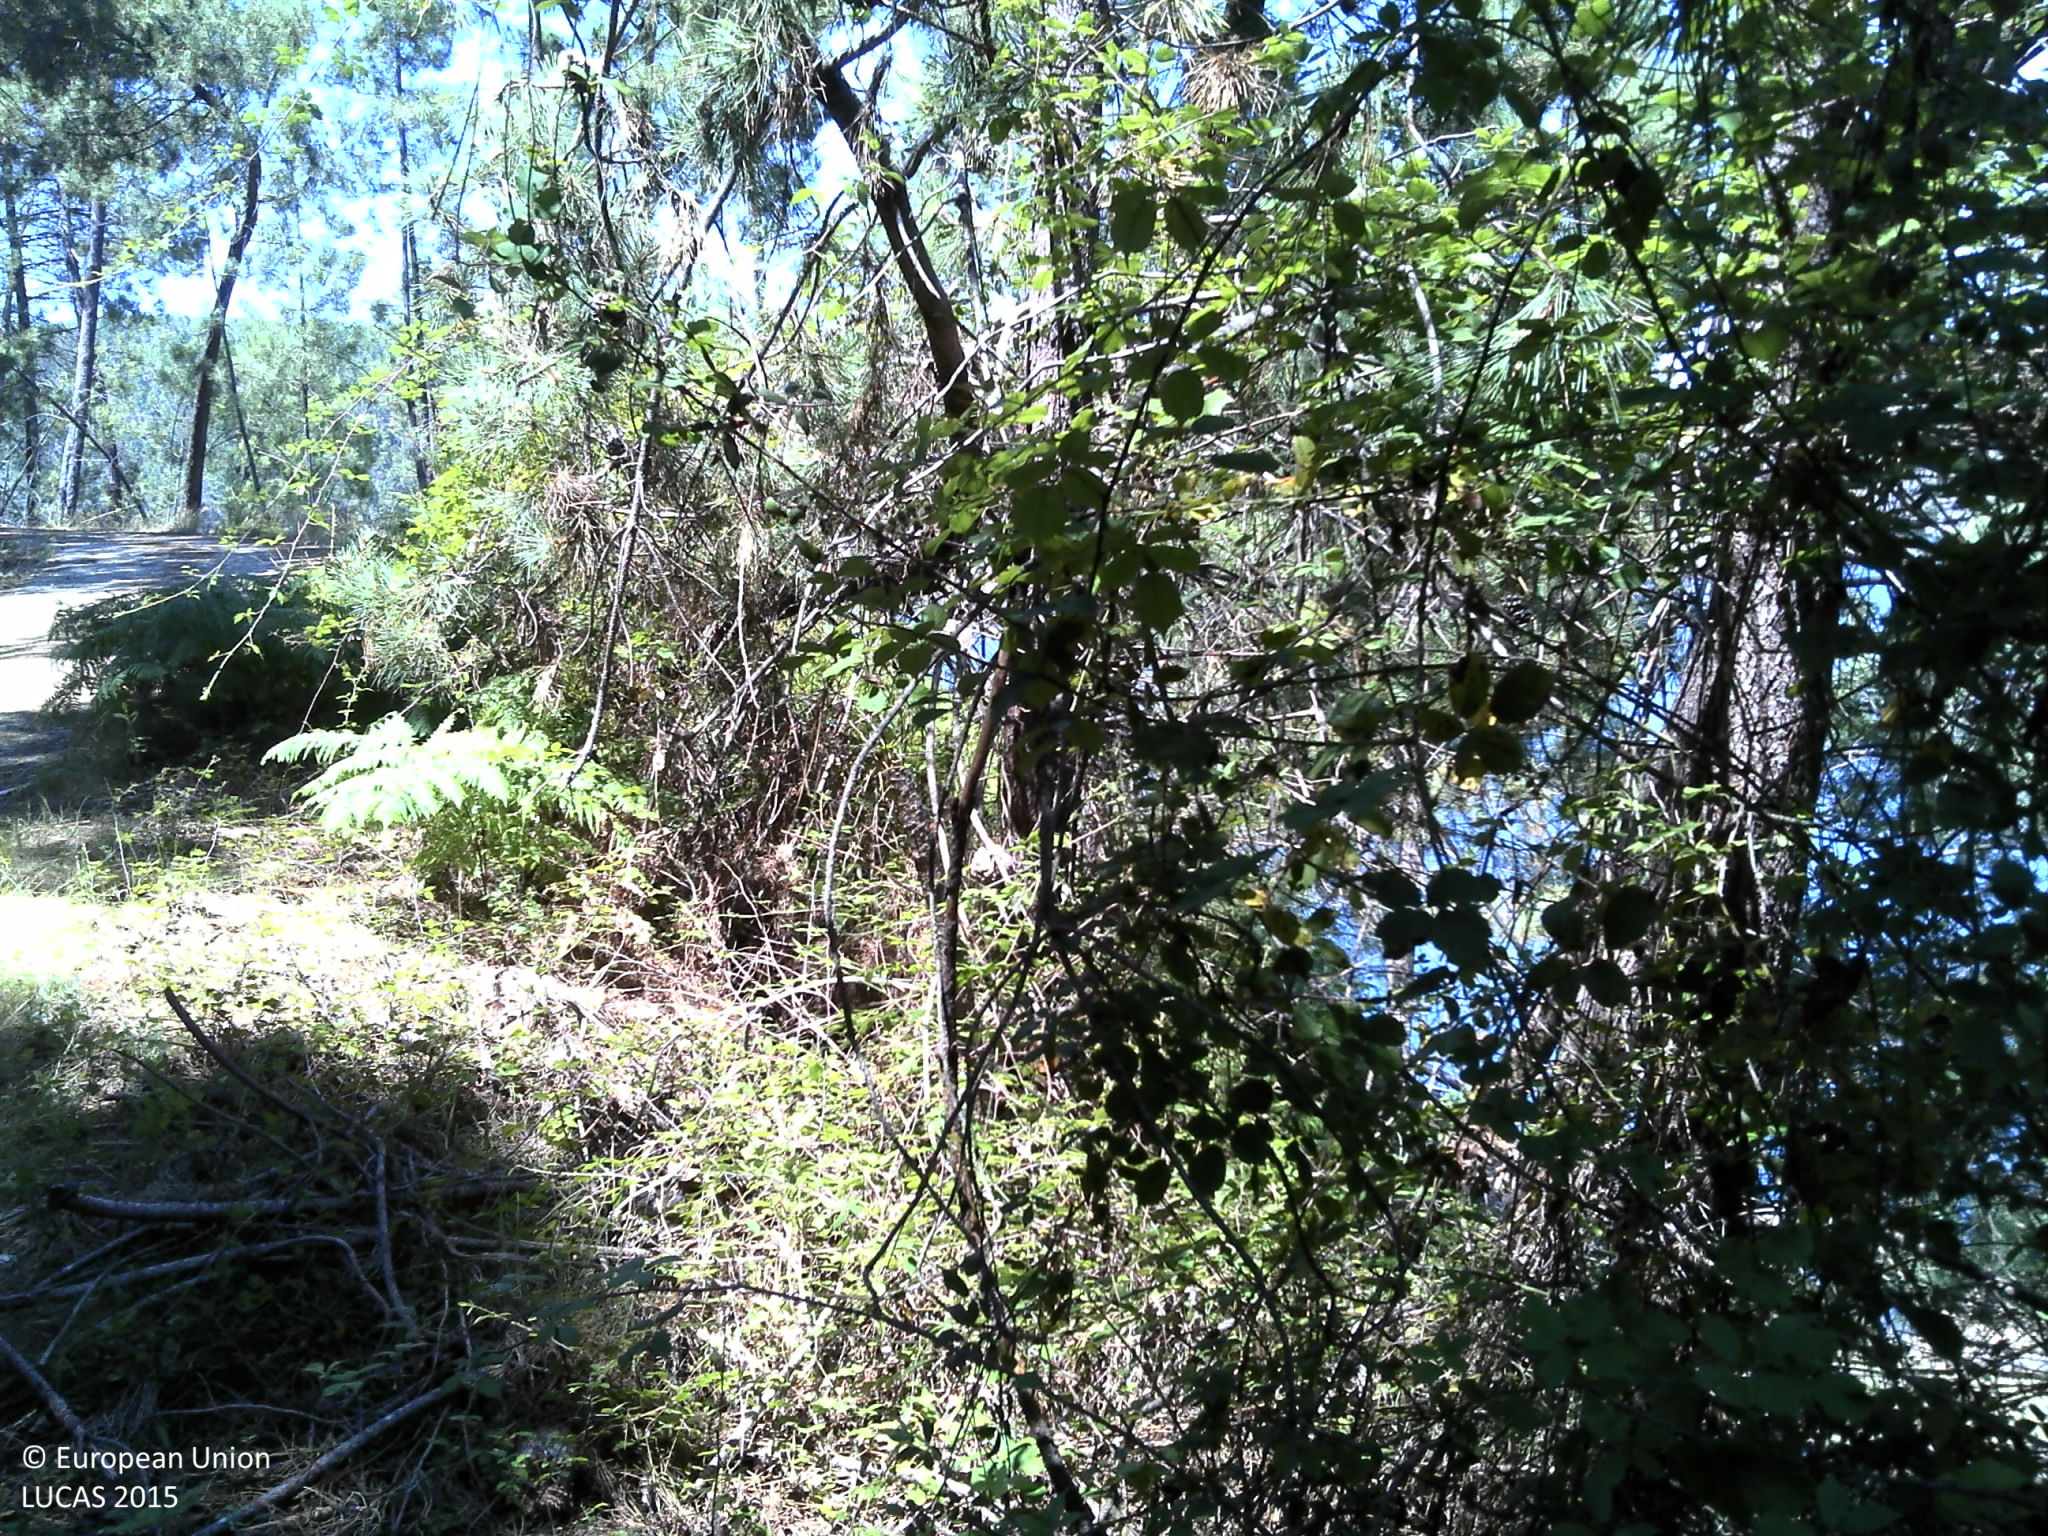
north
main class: Woodland
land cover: Pine dominated coniferous woodland
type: coniferous forest of the mediterranean region
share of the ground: 10 - 25 %
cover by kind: shrubs 80 %, coniferous forest trees 15 %, unconsolidated bare surface 5 %
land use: Forestry
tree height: > 5 m
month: July
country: PT
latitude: 39.9309
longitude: -8.1257
